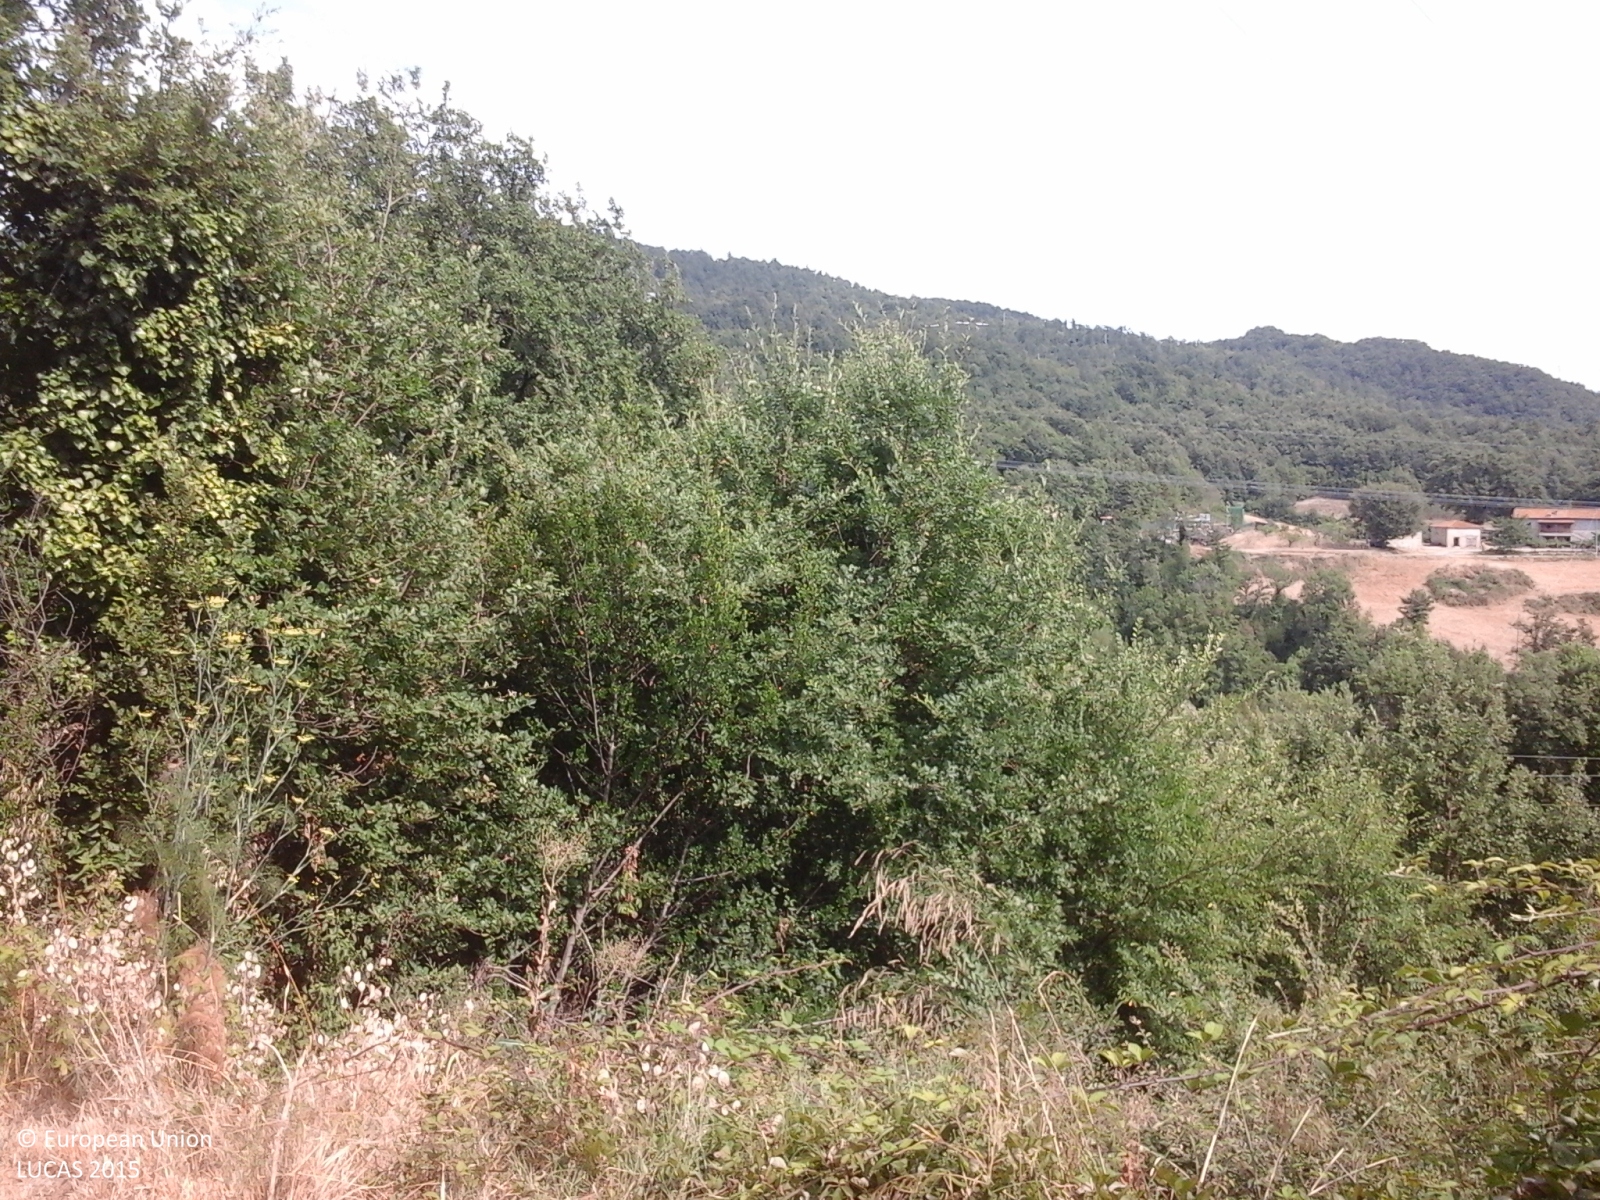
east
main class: Woodland
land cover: Broadleaved woodland
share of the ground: > 75 %
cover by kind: broadleaved forest trees 100 %
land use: Forestry
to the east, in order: Broadleaved woodland; Grassland without tree/shrub cover; Olive groves; Grassland without tree/shrub cover; Broadleaved woodland; Olive groves; Grassland without tree/shrub cover; Ditches and canals; Olive groves; Grassland without tree/shrub cover
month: August
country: IT
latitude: 43.1922
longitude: 10.8465
